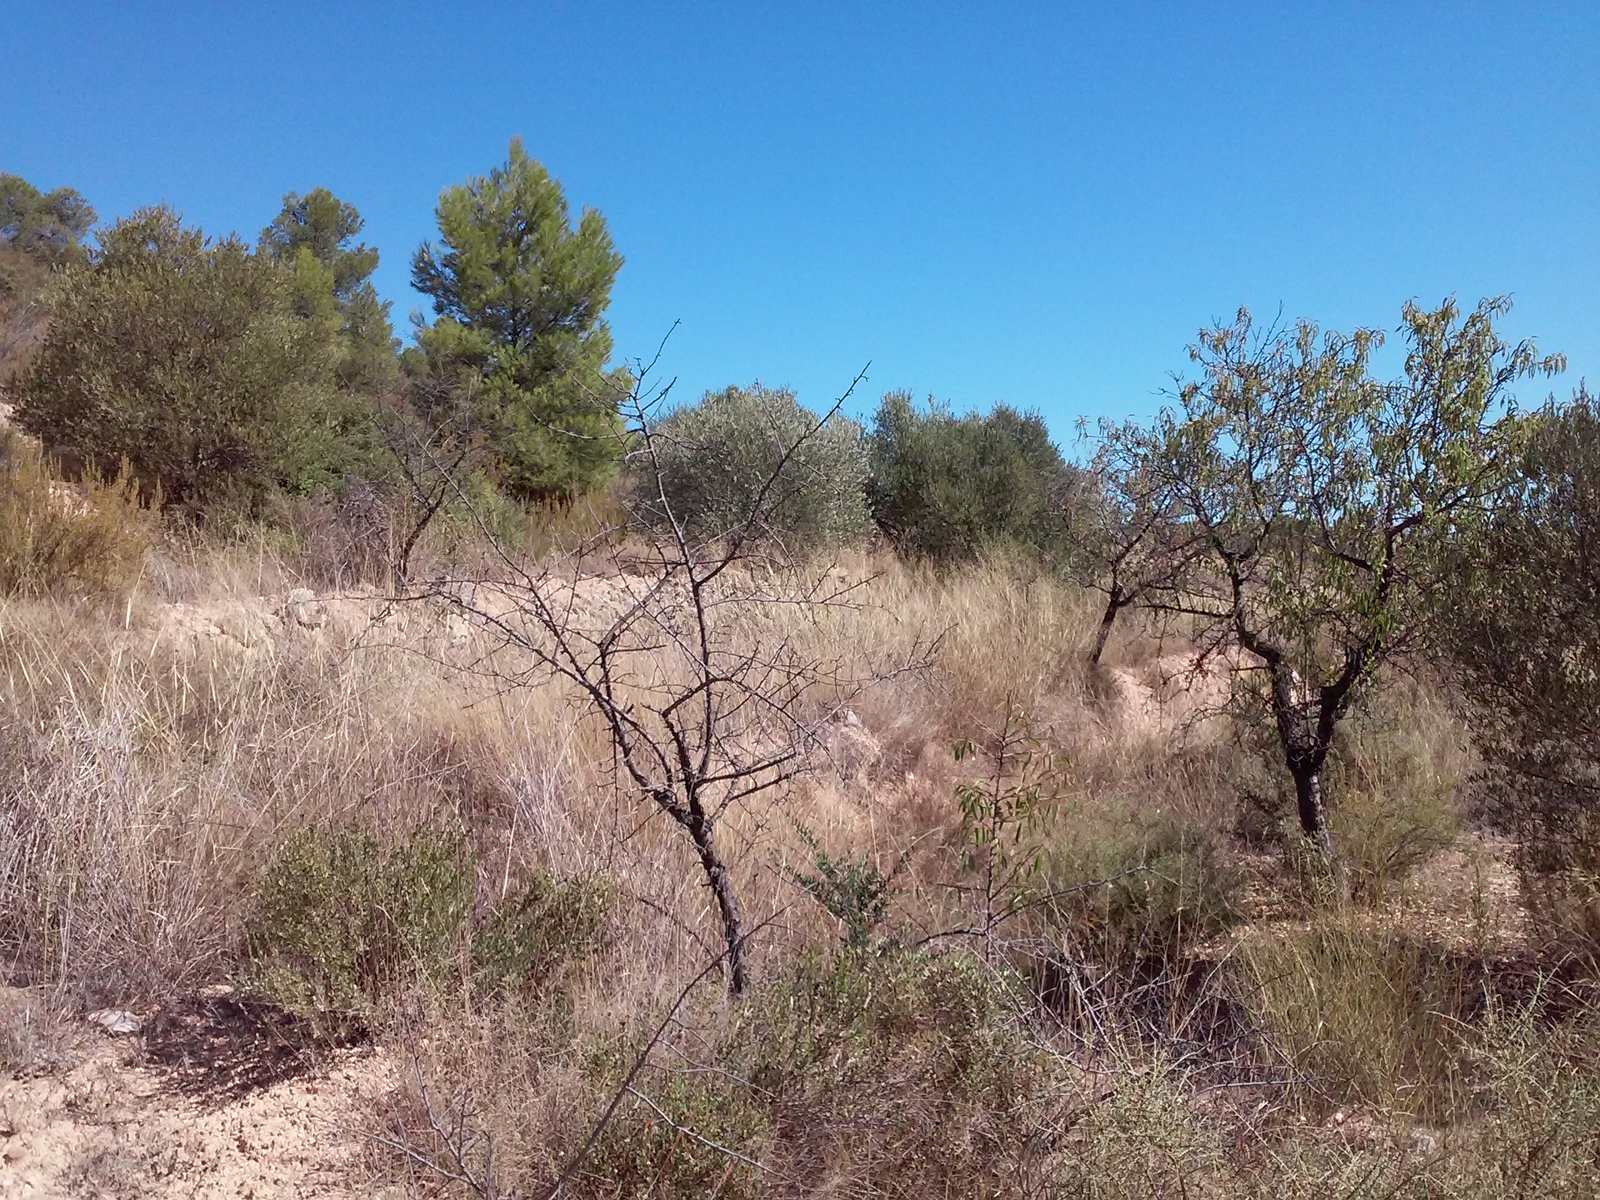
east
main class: Cropland
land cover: Nuts trees
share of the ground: 10 - 25 %
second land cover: Grassland without tree/shrub cover
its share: > 75 %
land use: Abandoned areas
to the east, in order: Nuts trees; Grassland without tree/shrub cover; Shrubland with sparse tree cover; Olive groves; Shrubland with sparse tree cover
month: September
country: ES
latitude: 41.2165
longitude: 0.6038
